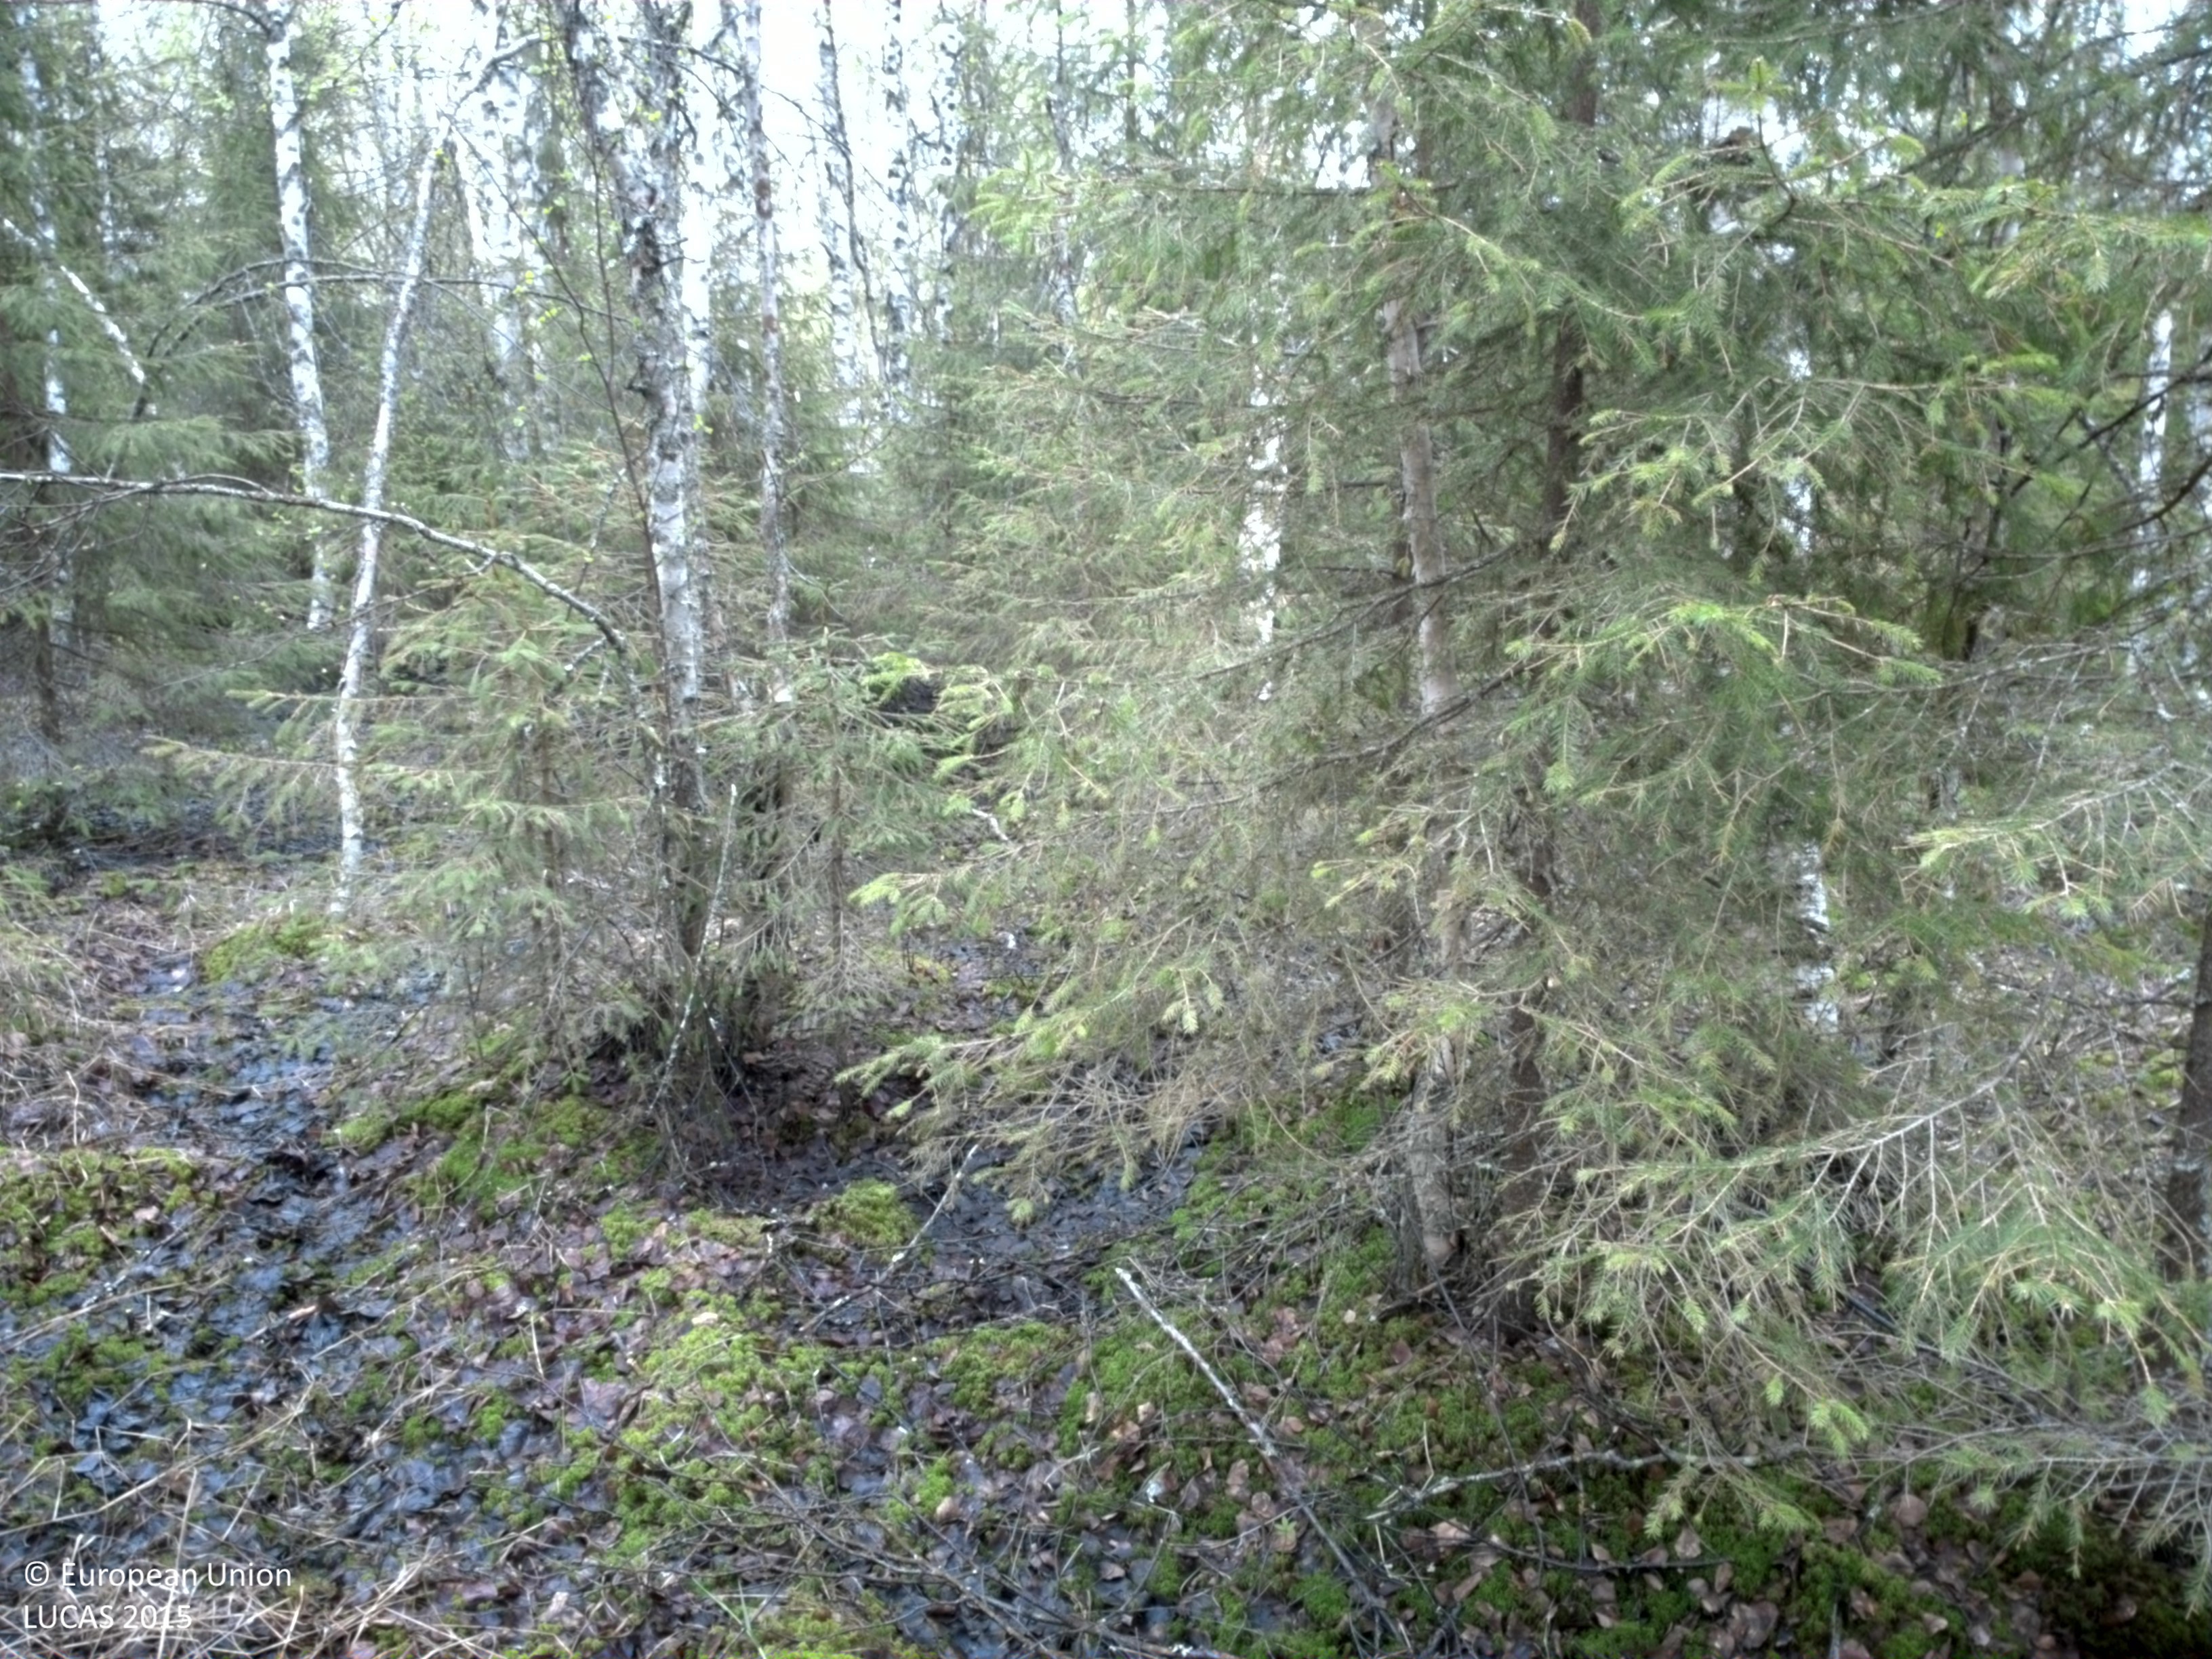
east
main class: Woodland
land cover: Broadleaved woodland
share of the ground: > 75 %
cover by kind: broadleaved forest trees 75 %, coniferous forest trees 10 %, lichens and mosses 10 %, herbaceous plants 5 %
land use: Forestry
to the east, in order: Broadleaved woodland; Ditches and canals; Broadleaved woodland; Ditches and canals; Broadleaved woodland; Ditches and canals; Broadleaved woodland; Ditches and canals; Broadleaved woodland; Shrubland with sparse tree cover
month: June
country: SE
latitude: 65.9327
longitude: 23.2840
